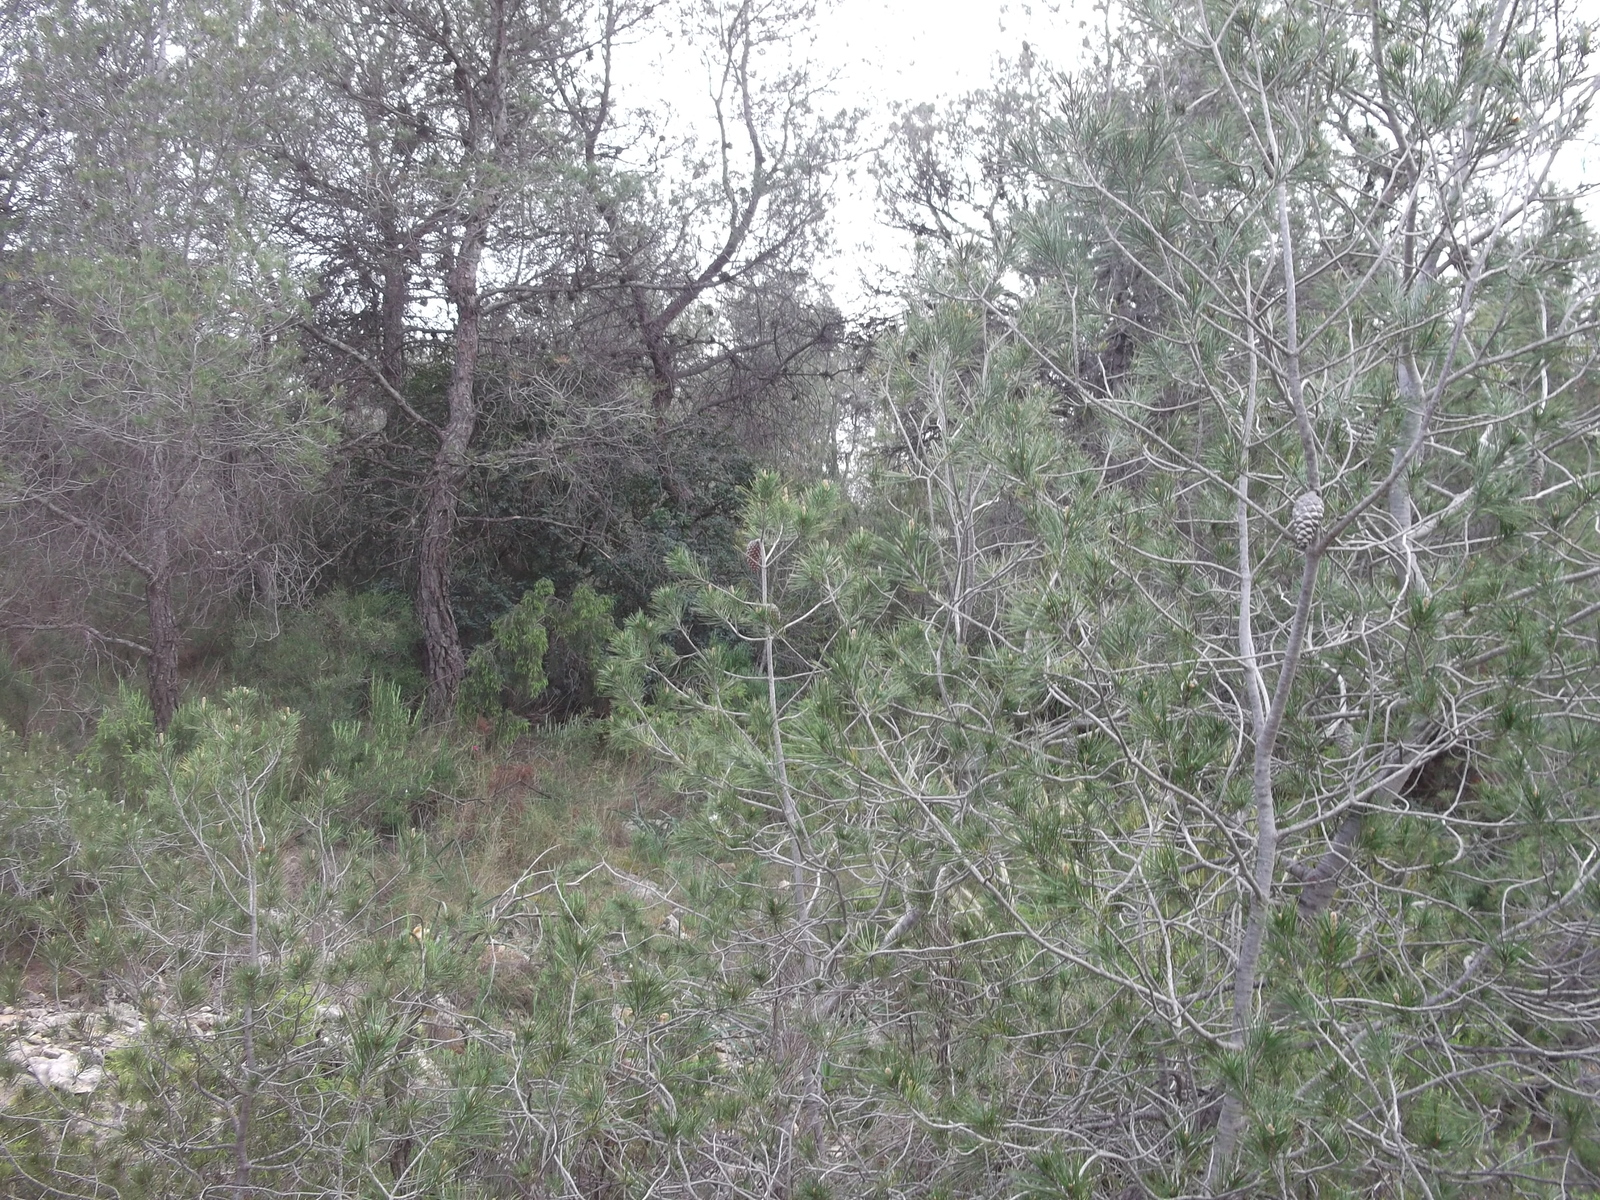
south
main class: Woodland
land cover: Pine dominated coniferous woodland
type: coniferous forest of the mediterranean region
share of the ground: 25 - 50 %
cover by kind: shrubs 70 %, coniferous forest trees 30 %
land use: Forestry
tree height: > 5 m
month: April
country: ES
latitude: 37.9425
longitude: -1.5121
